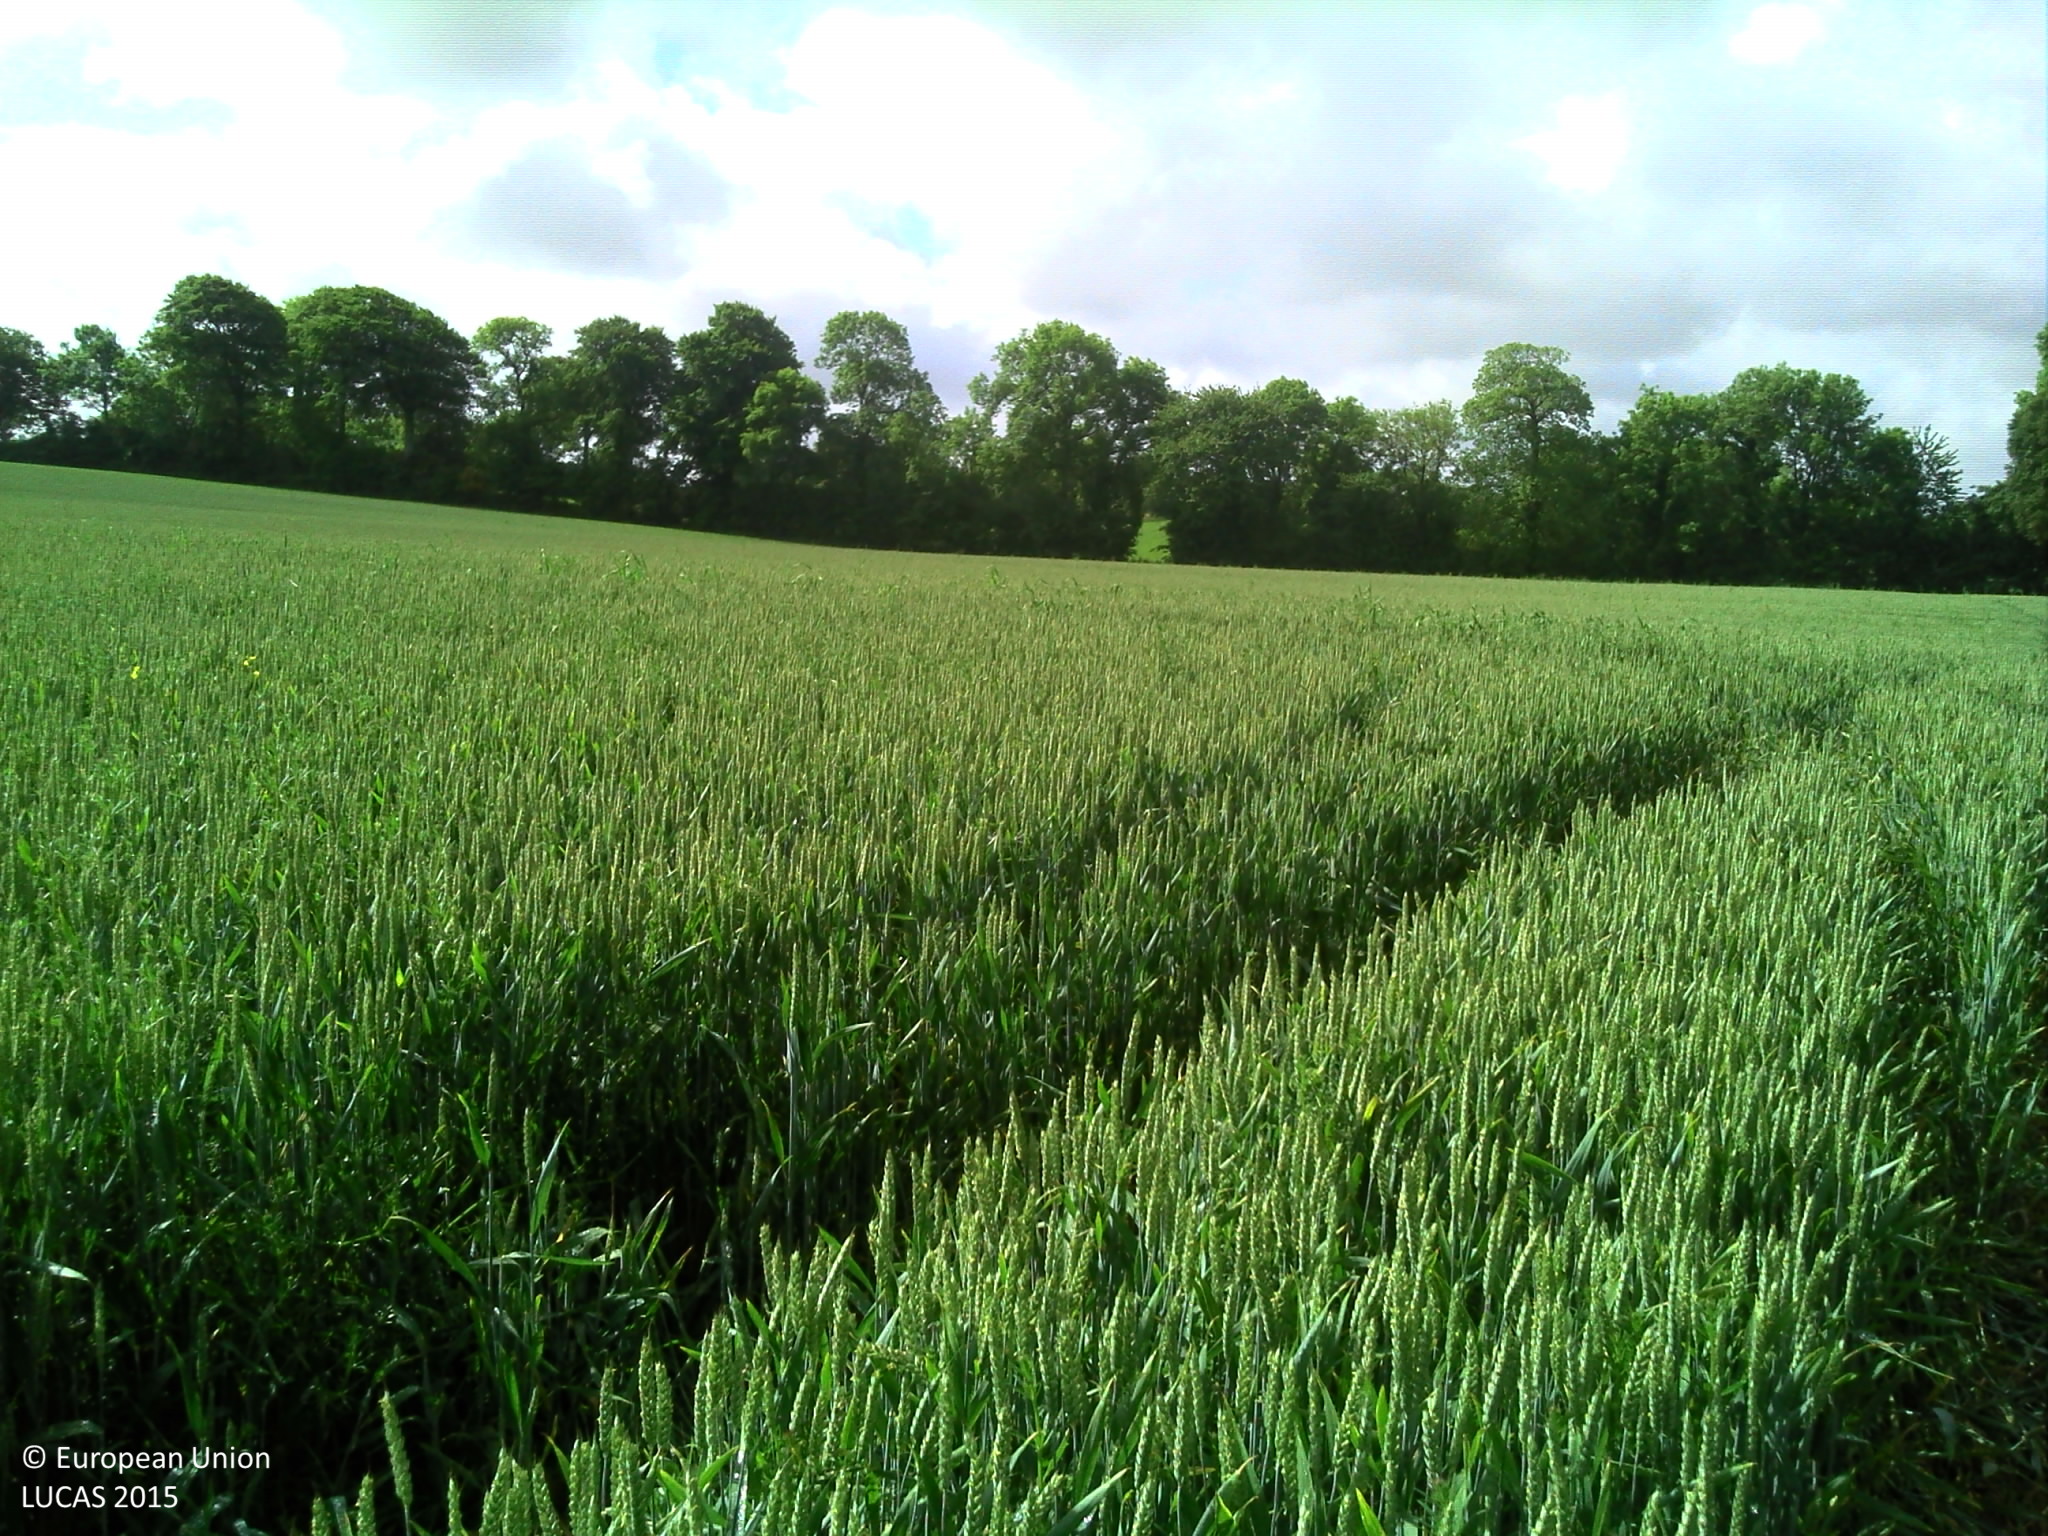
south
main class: Cropland
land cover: Common wheat
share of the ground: > 75 %
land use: Agriculture (excluding fallow land and kitchen gardens)
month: June
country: FR
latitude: 49.5577
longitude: -1.7343
